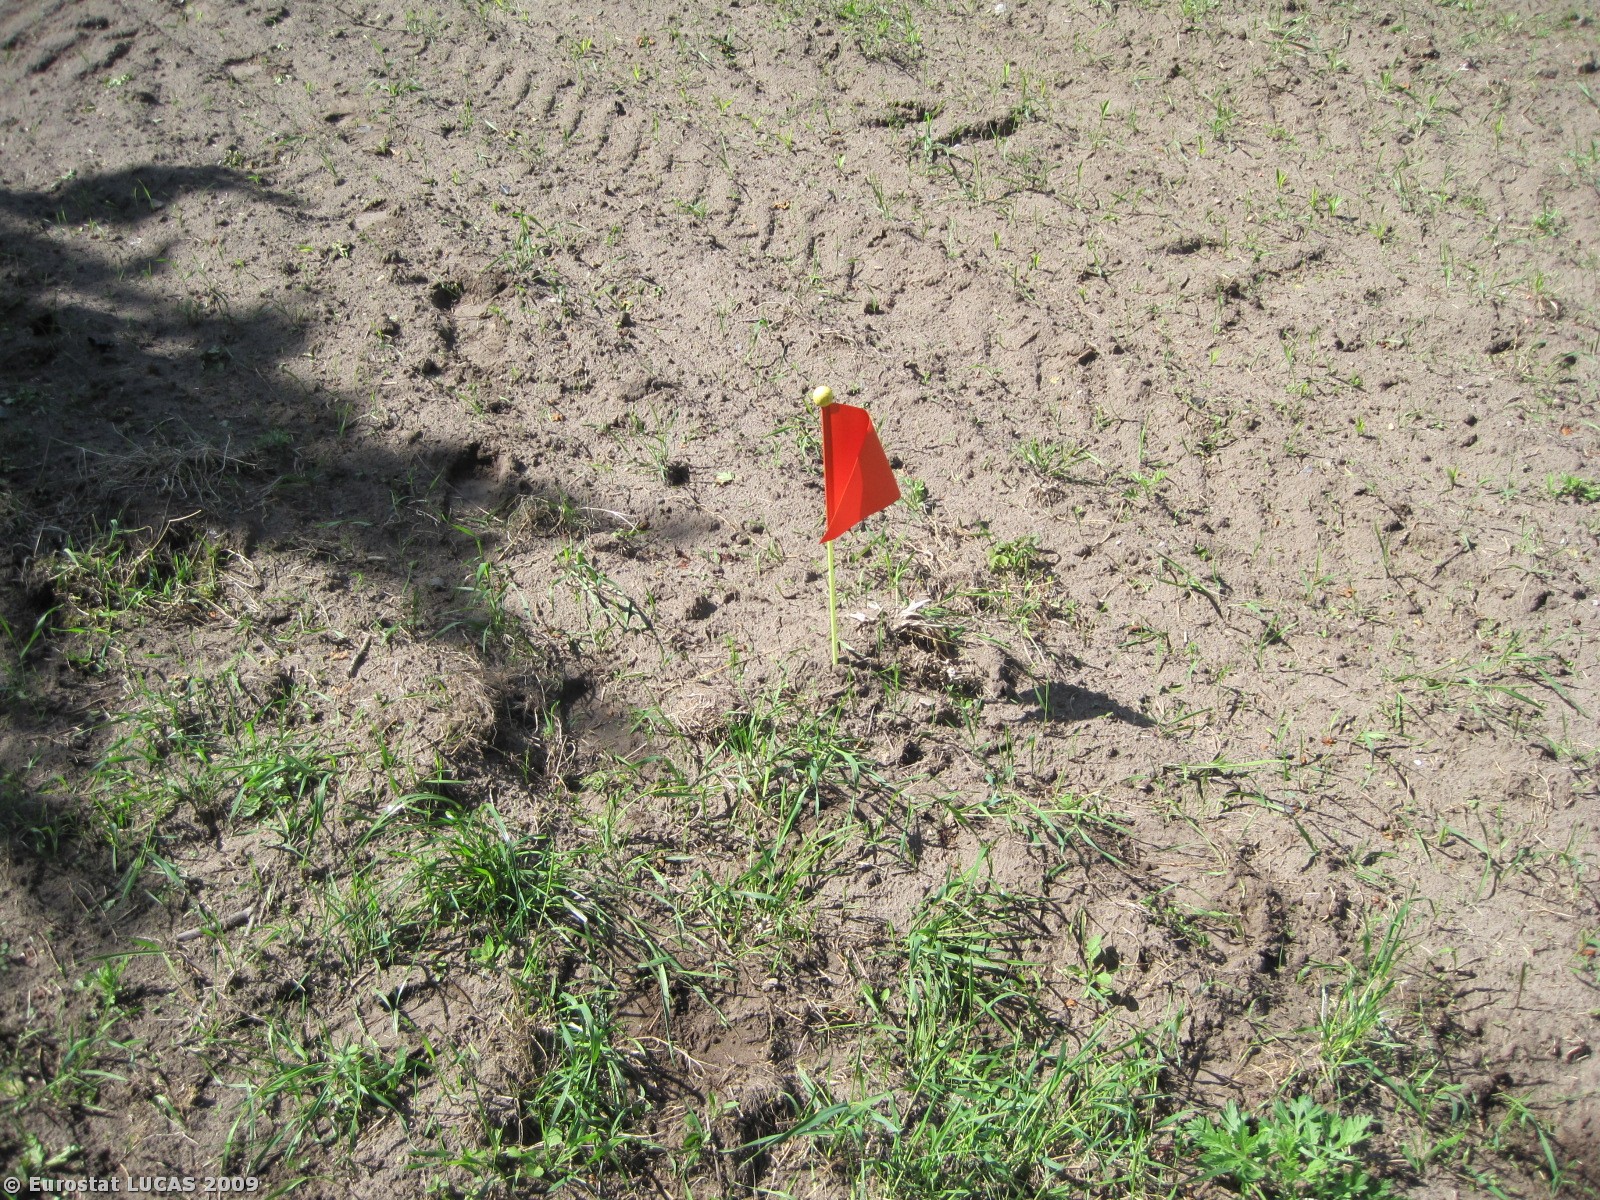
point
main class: Cropland
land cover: Maize
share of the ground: 10 - 25 %
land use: Agriculture (excluding fallow land and kitchen gardens)
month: May
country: DK
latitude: 56.8349
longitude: 10.0491
